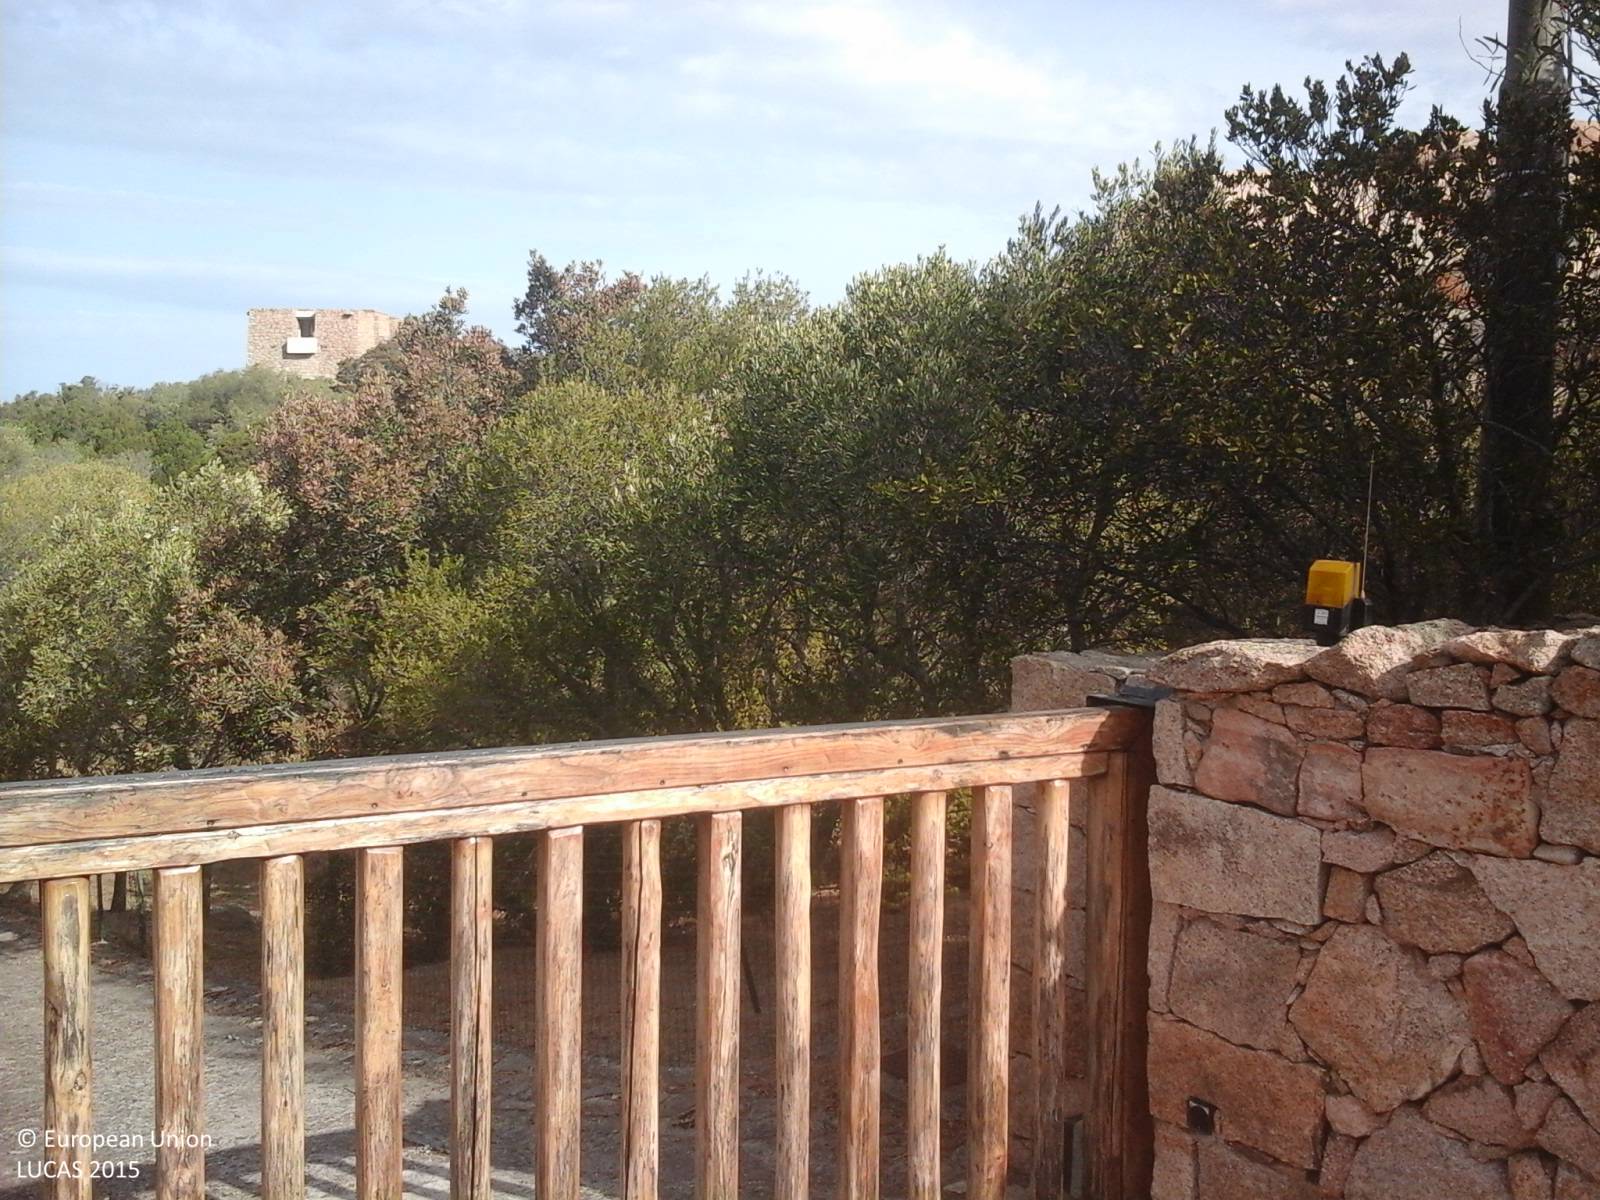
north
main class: Woodland
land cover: Broadleaved woodland
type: broadleaved evergreen forest
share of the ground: > 75 %
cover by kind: broadleaved forest trees 90 %, shrubs 5 %, unconsolidated bare surface 5 %
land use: Residential
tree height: > 5 m
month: September
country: IT
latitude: 41.1347
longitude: 9.5138
